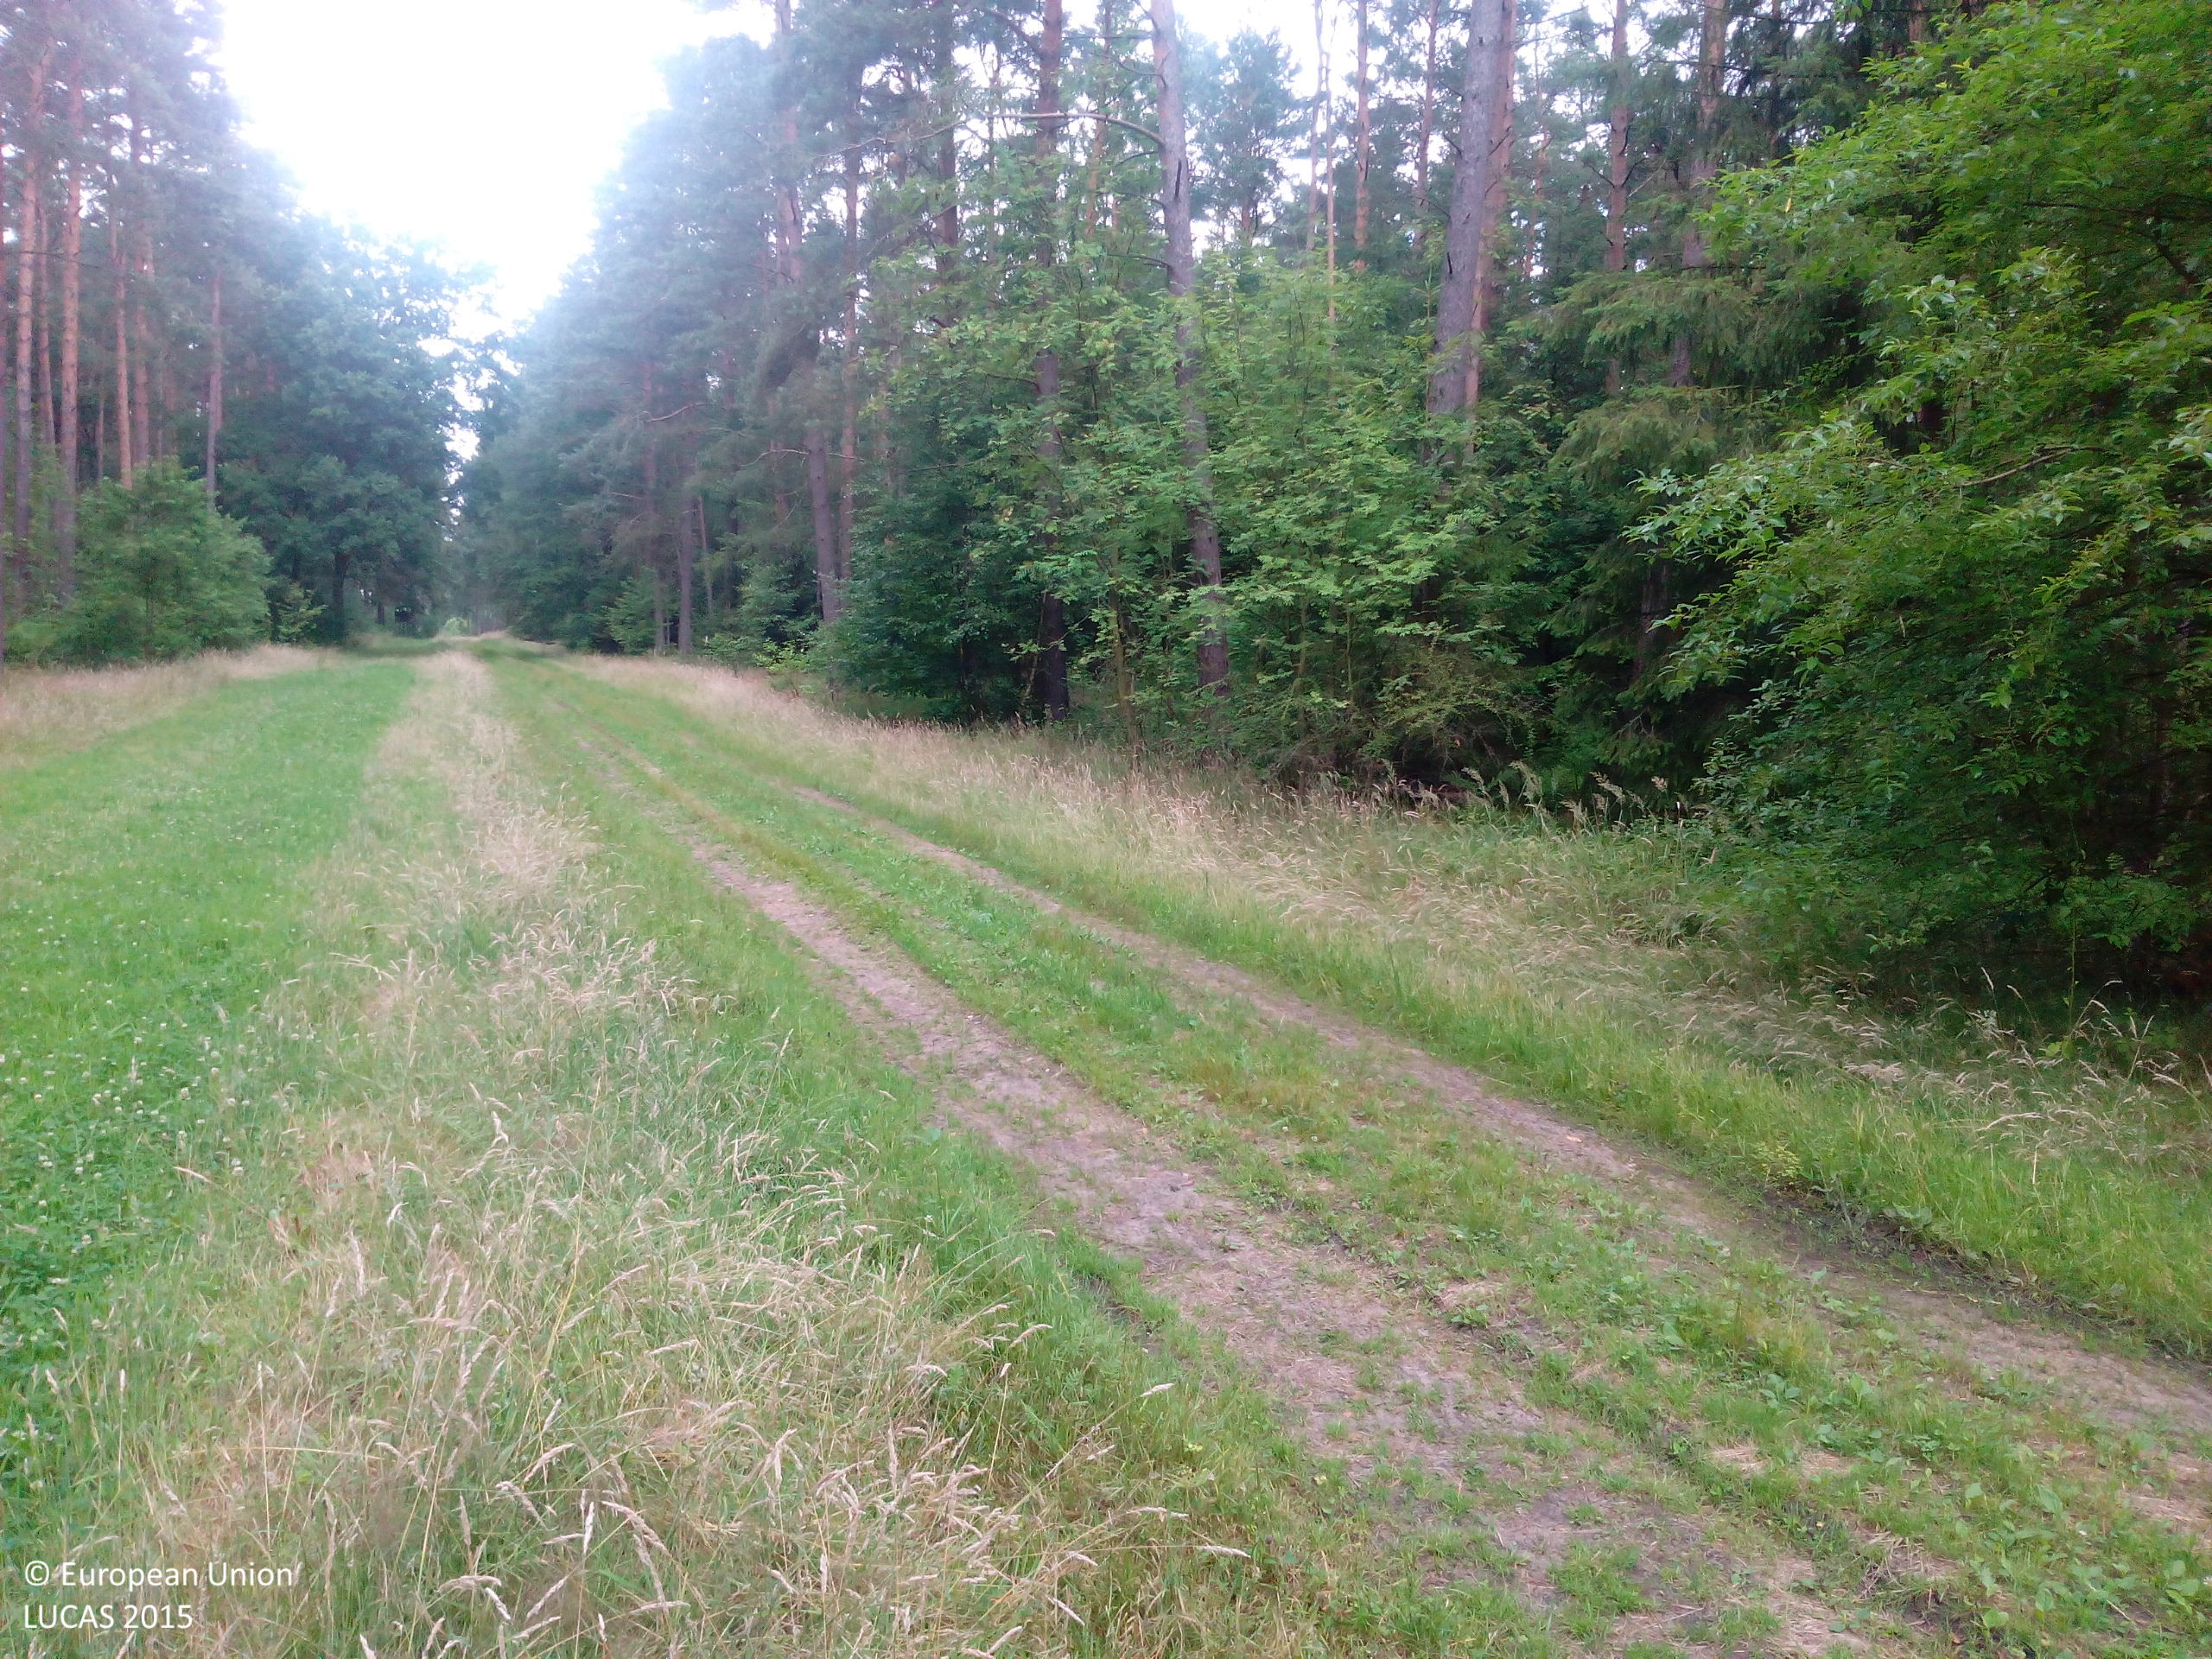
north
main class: Grassland
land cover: Grassland without tree/shrub cover
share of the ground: > 75 %
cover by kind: herbaceous plants 90 %, unconsolidated bare surface 10 %
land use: Road transport
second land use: Forestry
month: July
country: DE
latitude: 52.8444
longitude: 10.3117
